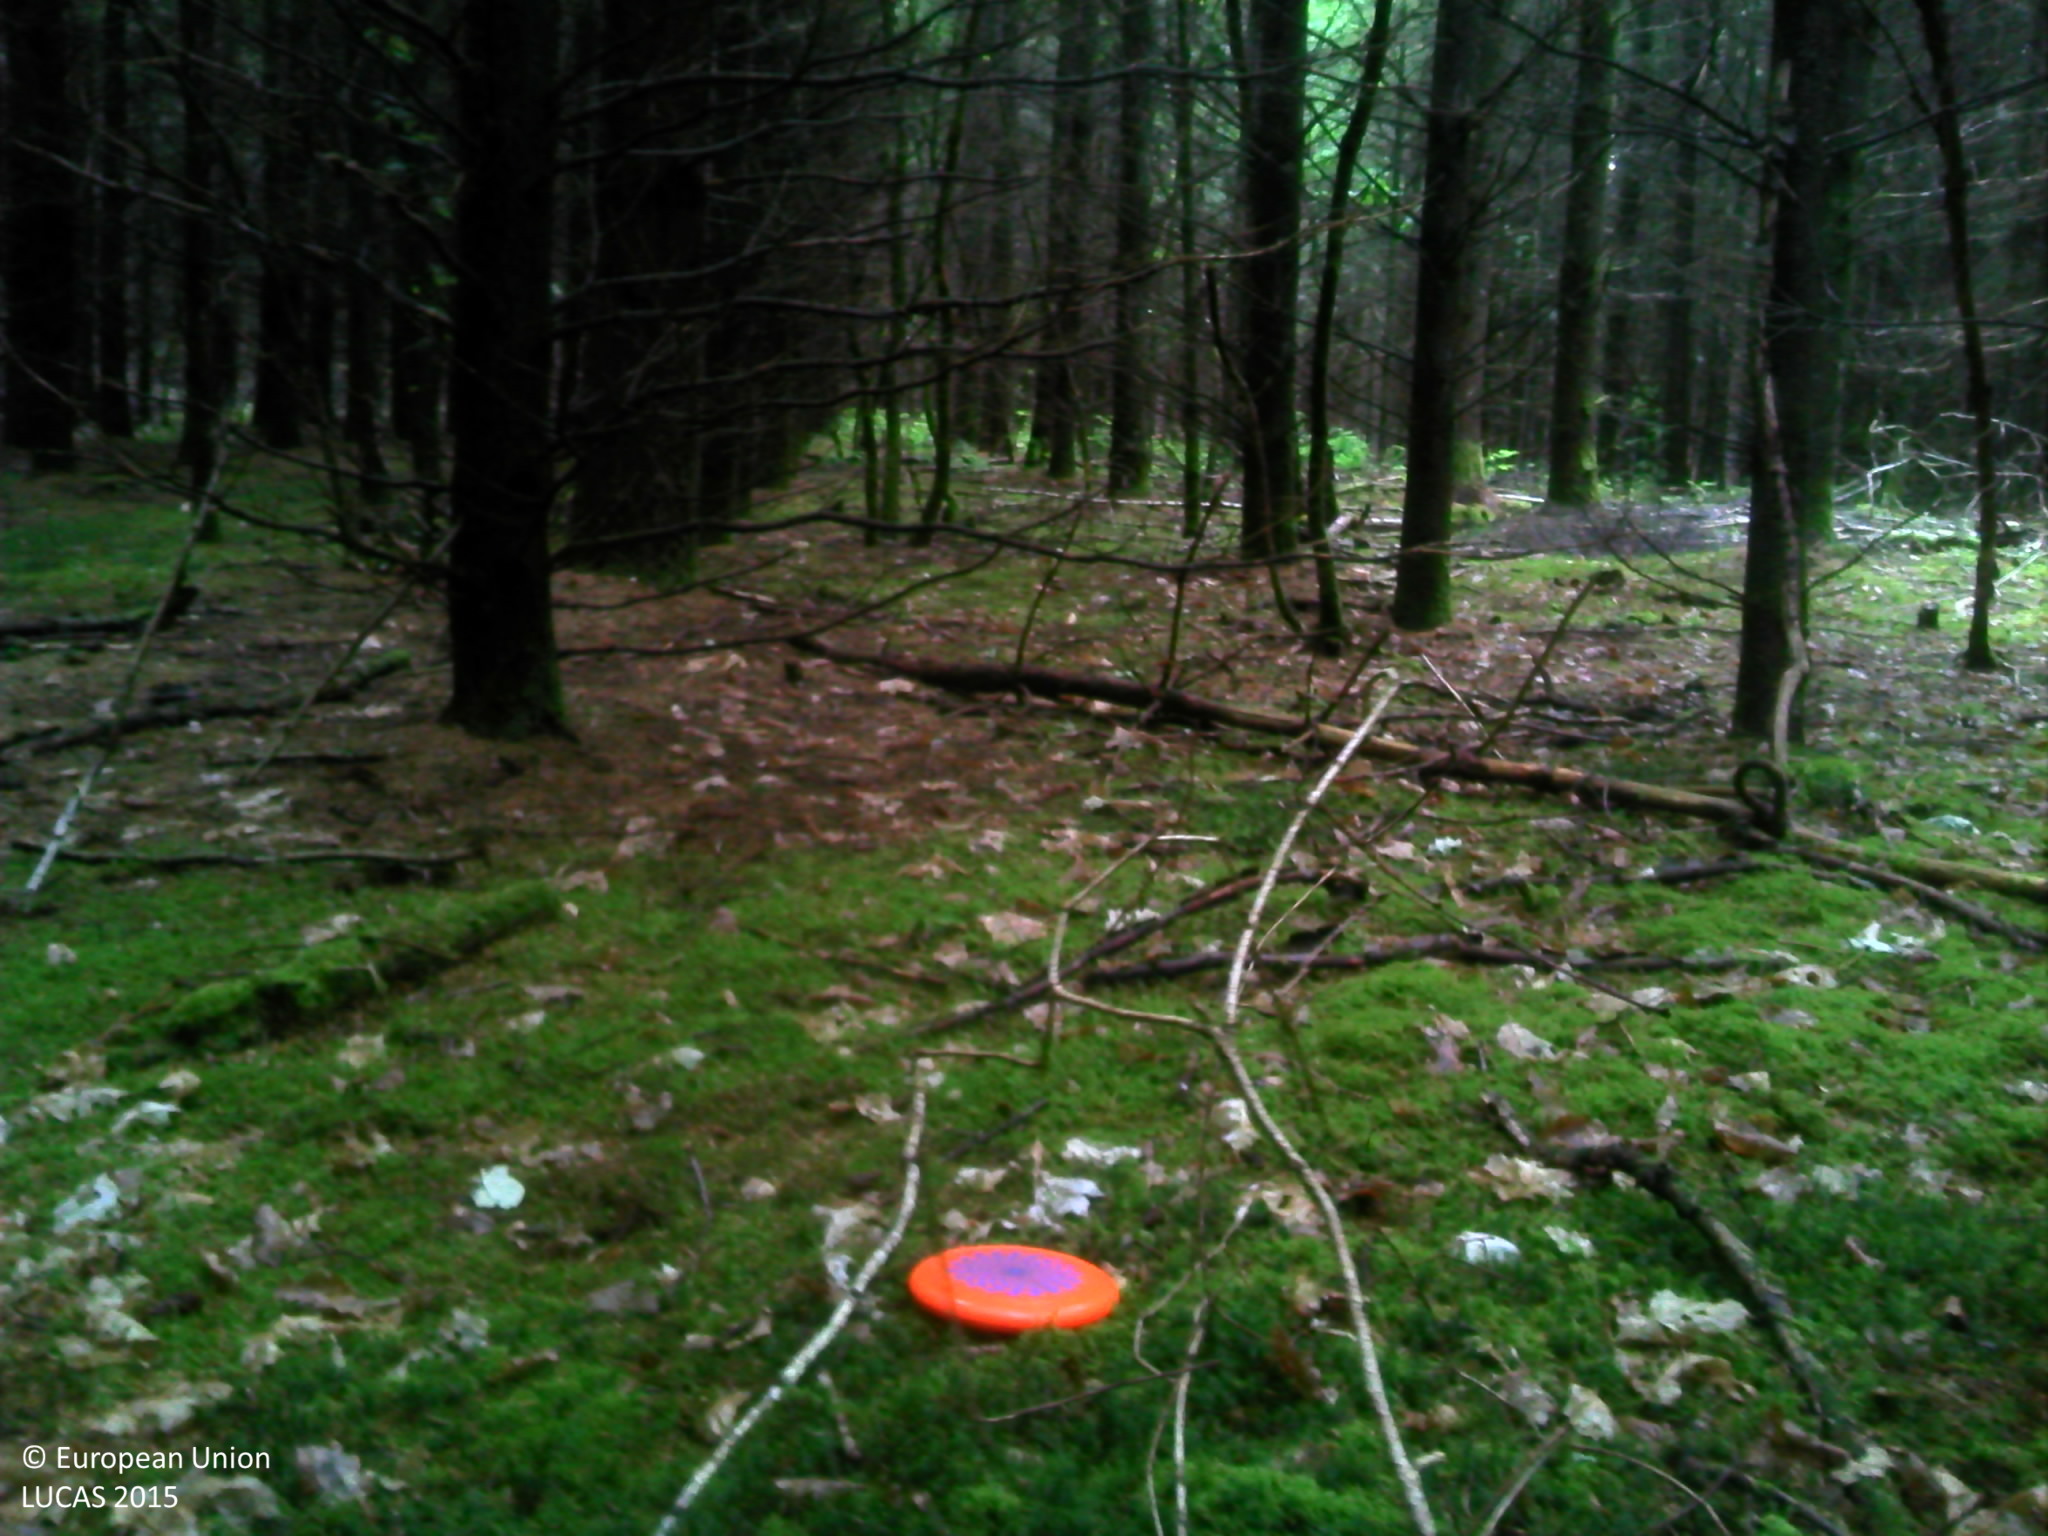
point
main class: Woodland
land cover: Other coniferous woodland
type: exotic forest
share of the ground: > 75 %
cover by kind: coniferous forest trees 90 %, herbaceous plants 10 %
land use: Forestry
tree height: > 5 m
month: July
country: FR
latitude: 46.4800
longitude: 4.4916
